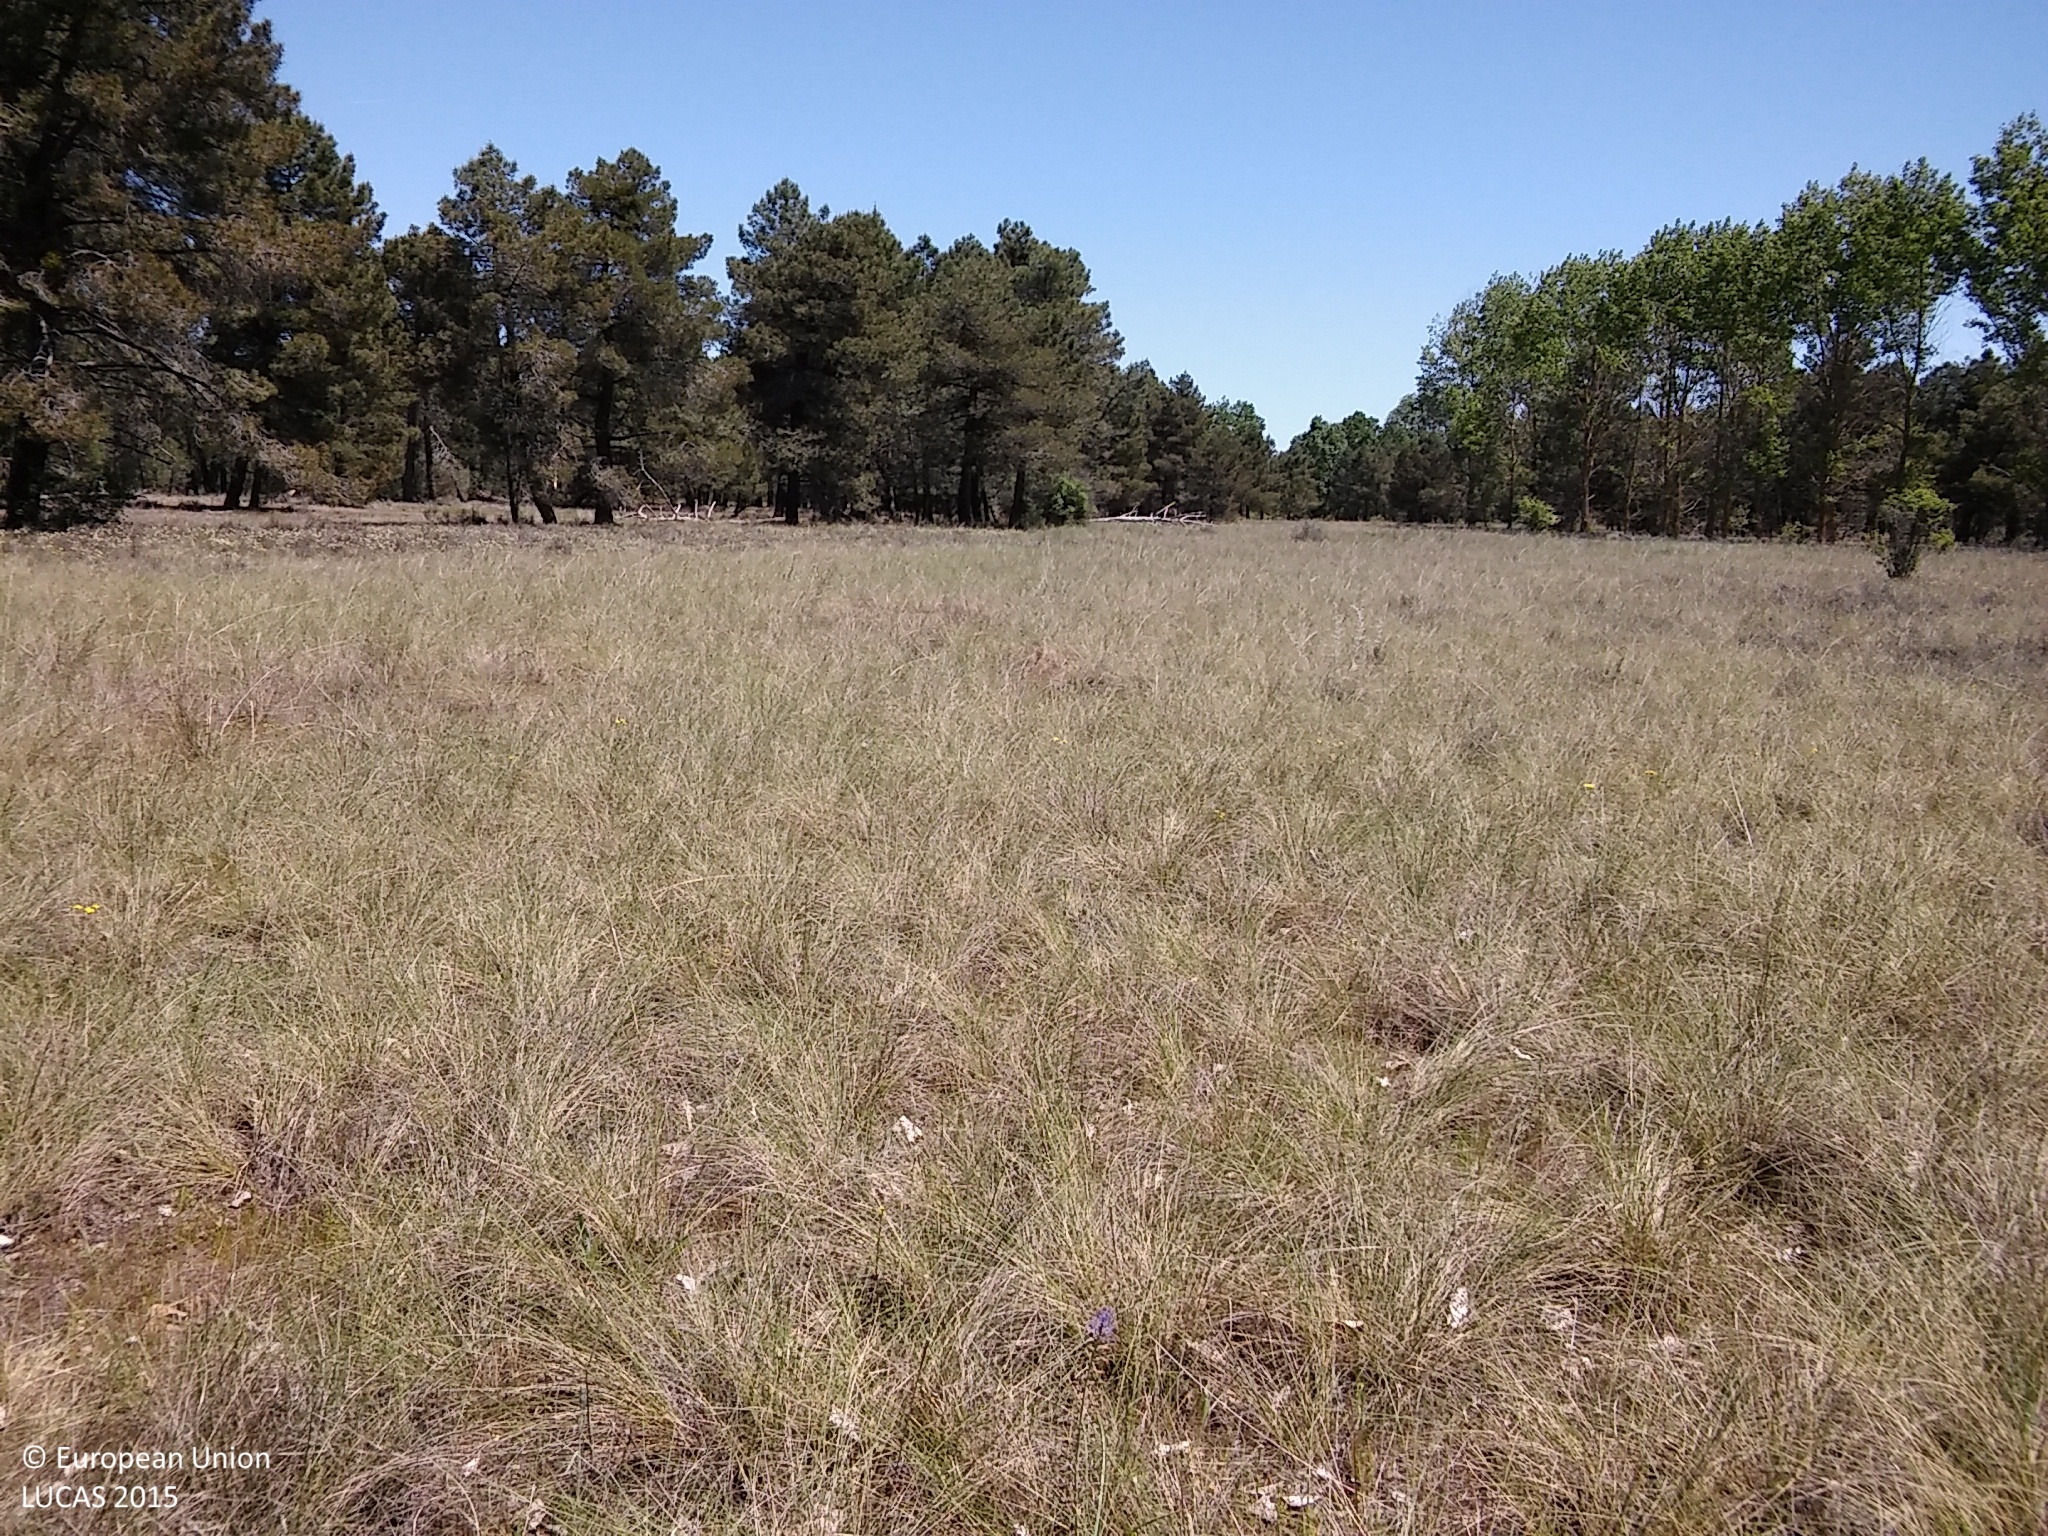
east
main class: Grassland
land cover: Grassland without tree/shrub cover
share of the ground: > 75 %
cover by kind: herbaceous plants 95 %, shrubs 5 %
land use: Semi-natural and natural areas not in use
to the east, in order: Grassland without tree/shrub cover; Pine dominated coniferous woodland; Grassland without tree/shrub cover; Pine dominated coniferous woodland
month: May
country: ES
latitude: 41.2269
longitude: -4.0702
